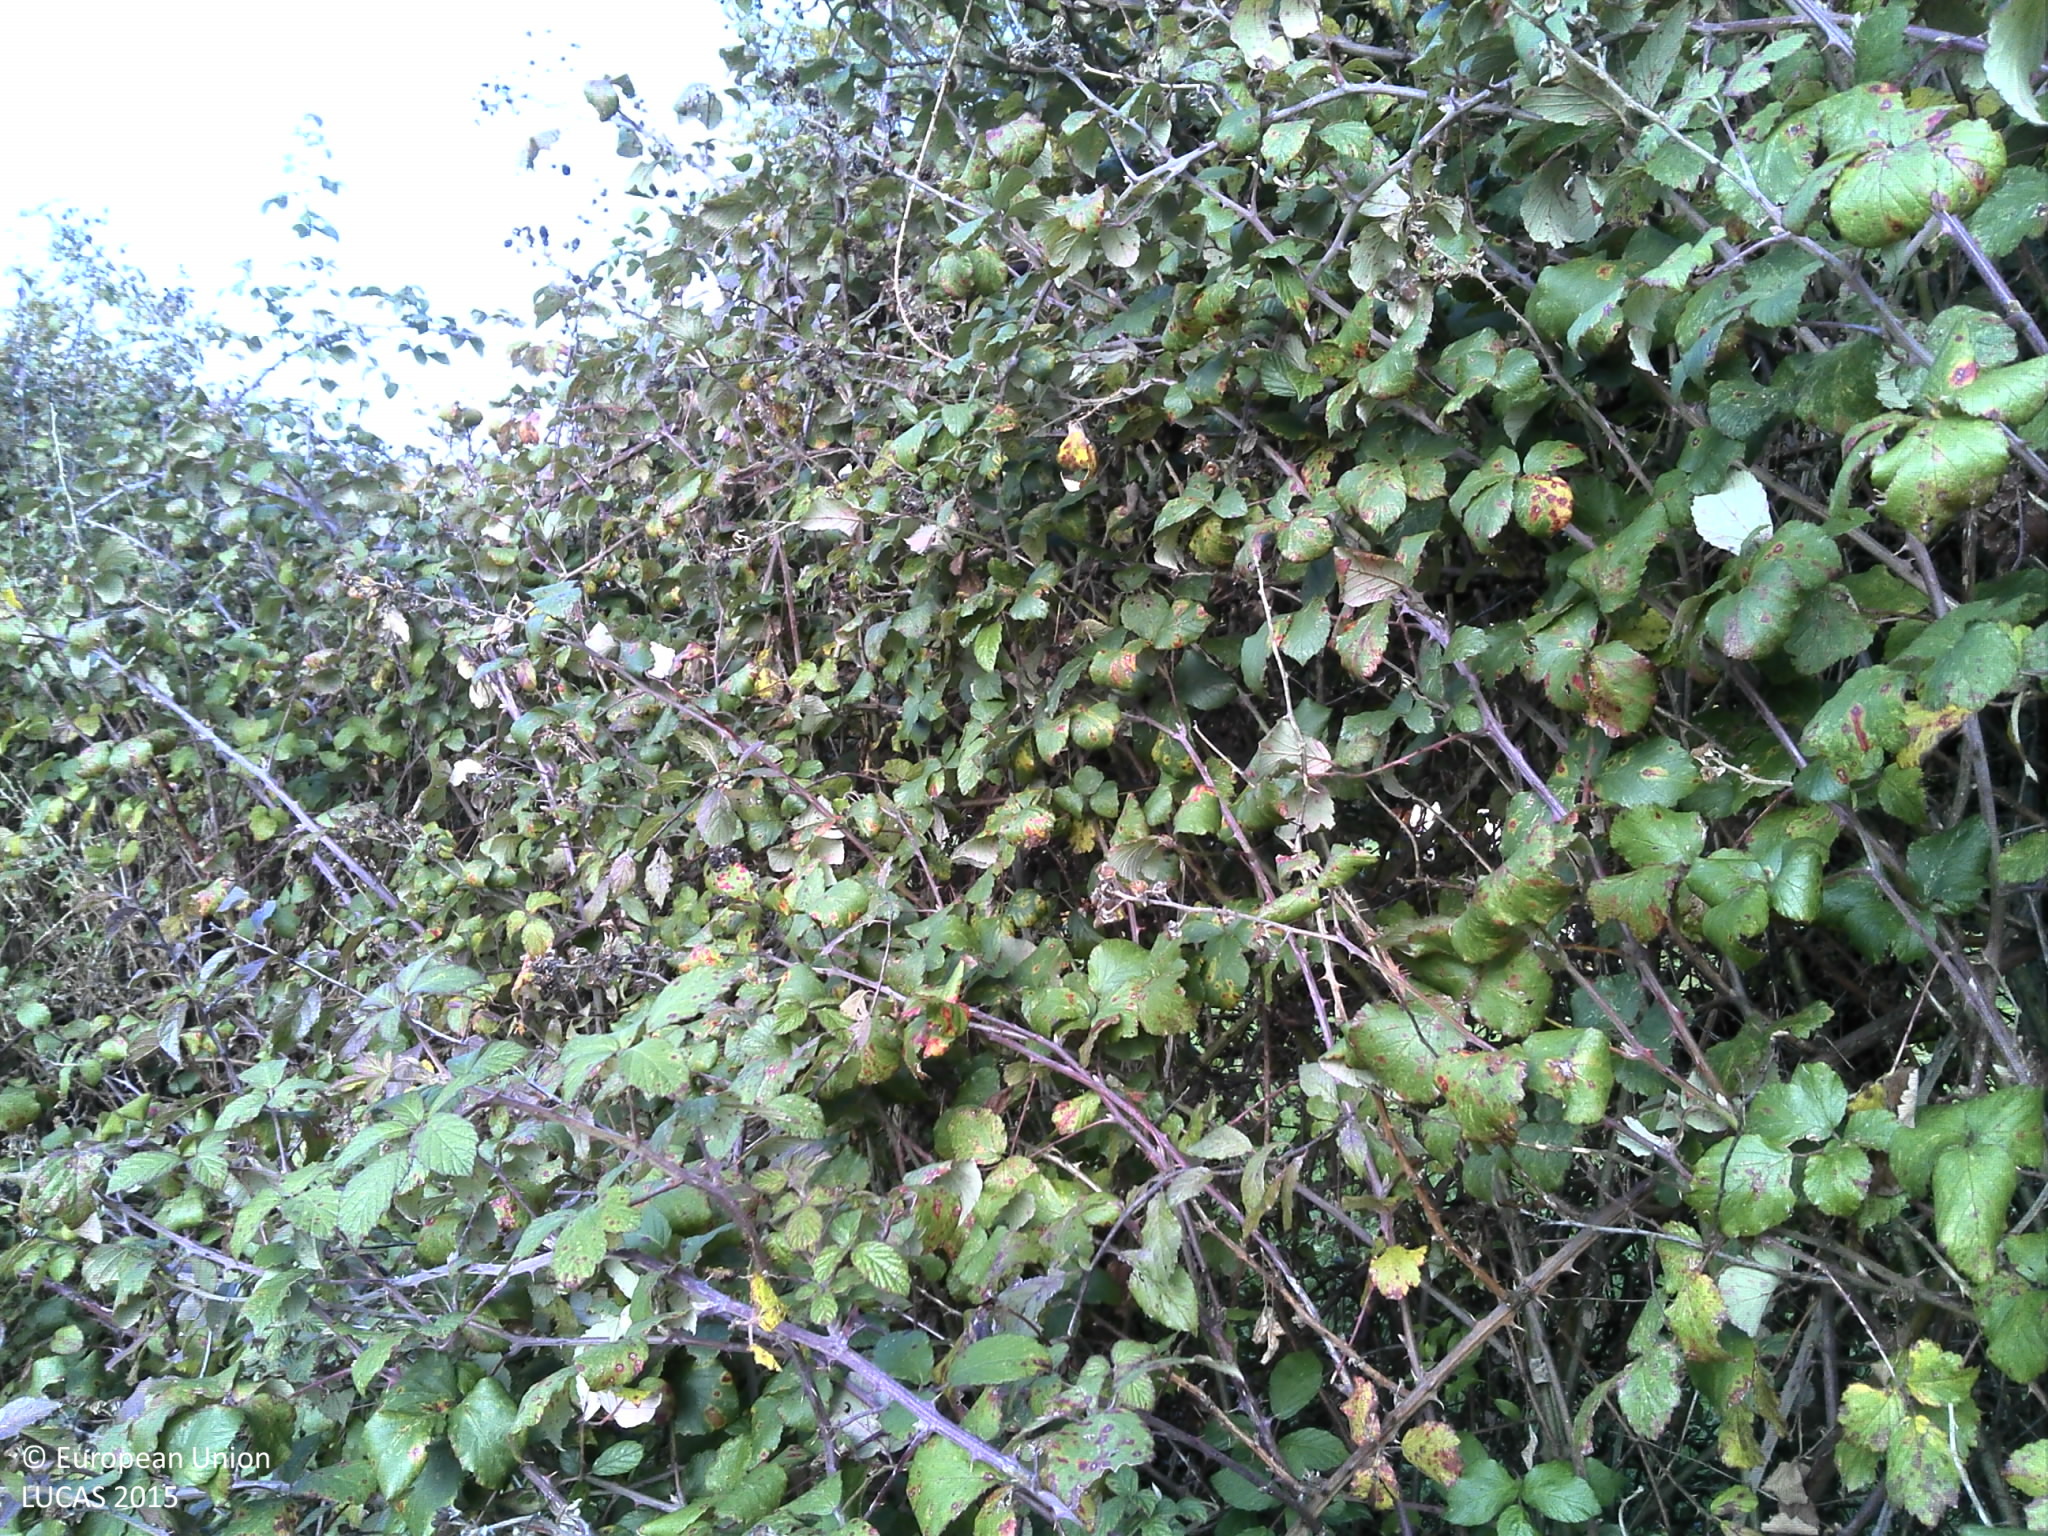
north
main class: Grassland
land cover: Grassland without tree/shrub cover
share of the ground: > 75 %
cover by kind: herbaceous plants 100 %
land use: Agriculture (excluding fallow land and kitchen gardens)
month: October
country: FR
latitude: 46.1433
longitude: 5.3816
